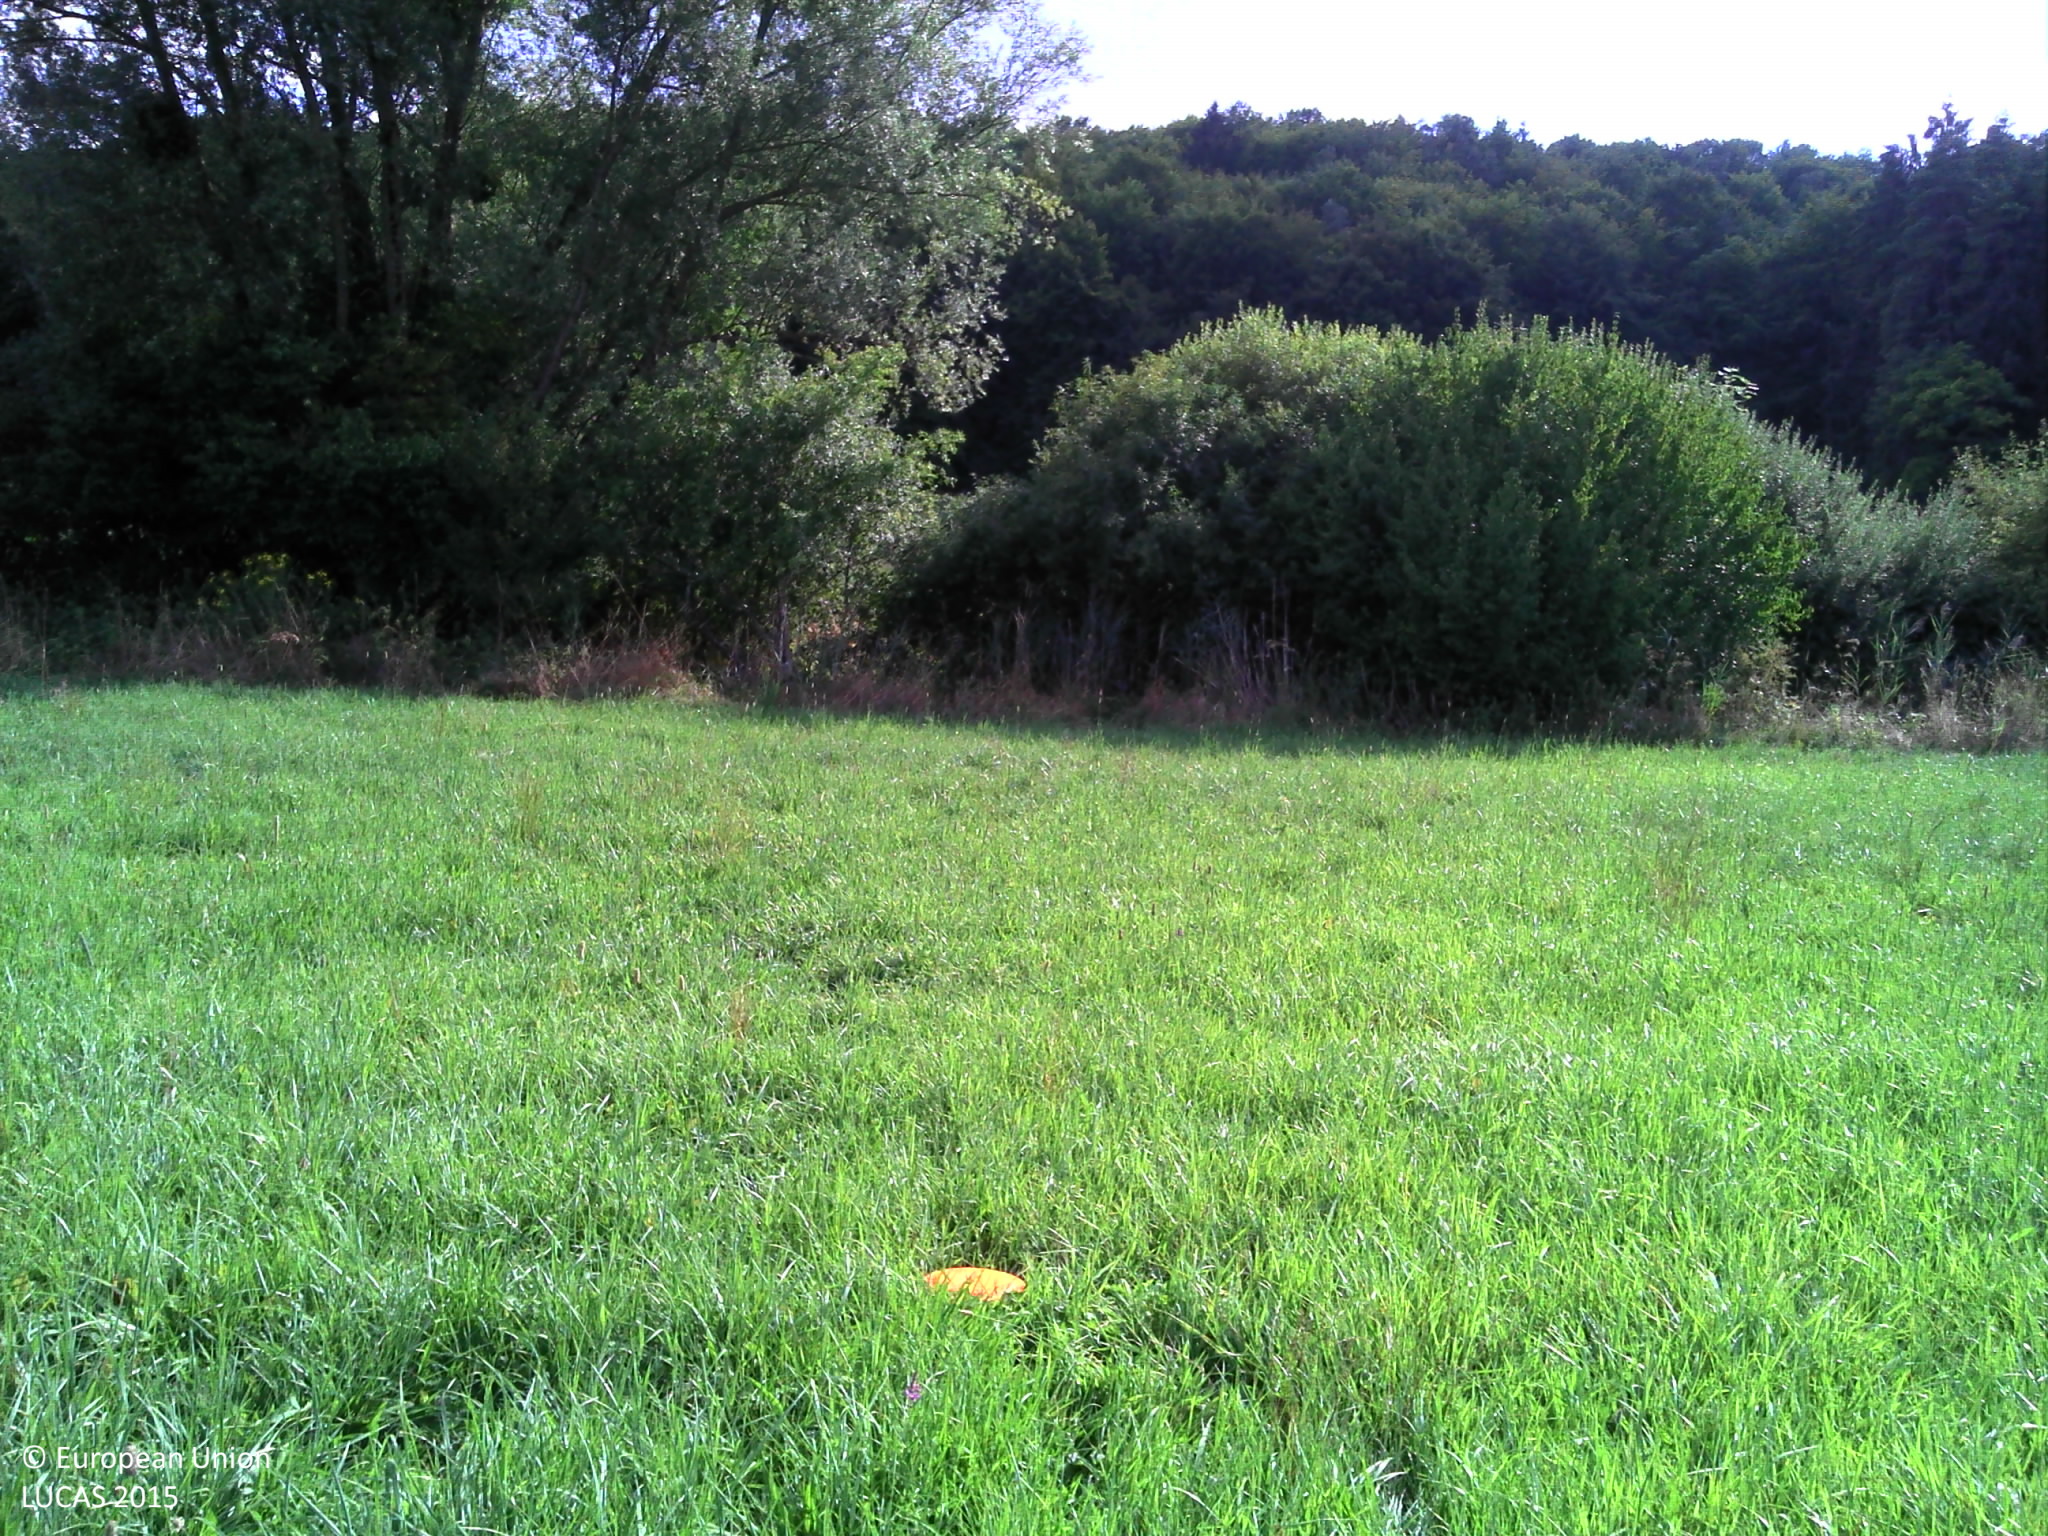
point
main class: Grassland
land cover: Grassland without tree/shrub cover
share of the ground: > 75 %
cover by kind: herbaceous plants 100 %
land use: Agriculture (excluding fallow land and kitchen gardens)
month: August
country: FR
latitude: 47.9689
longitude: 4.6809
